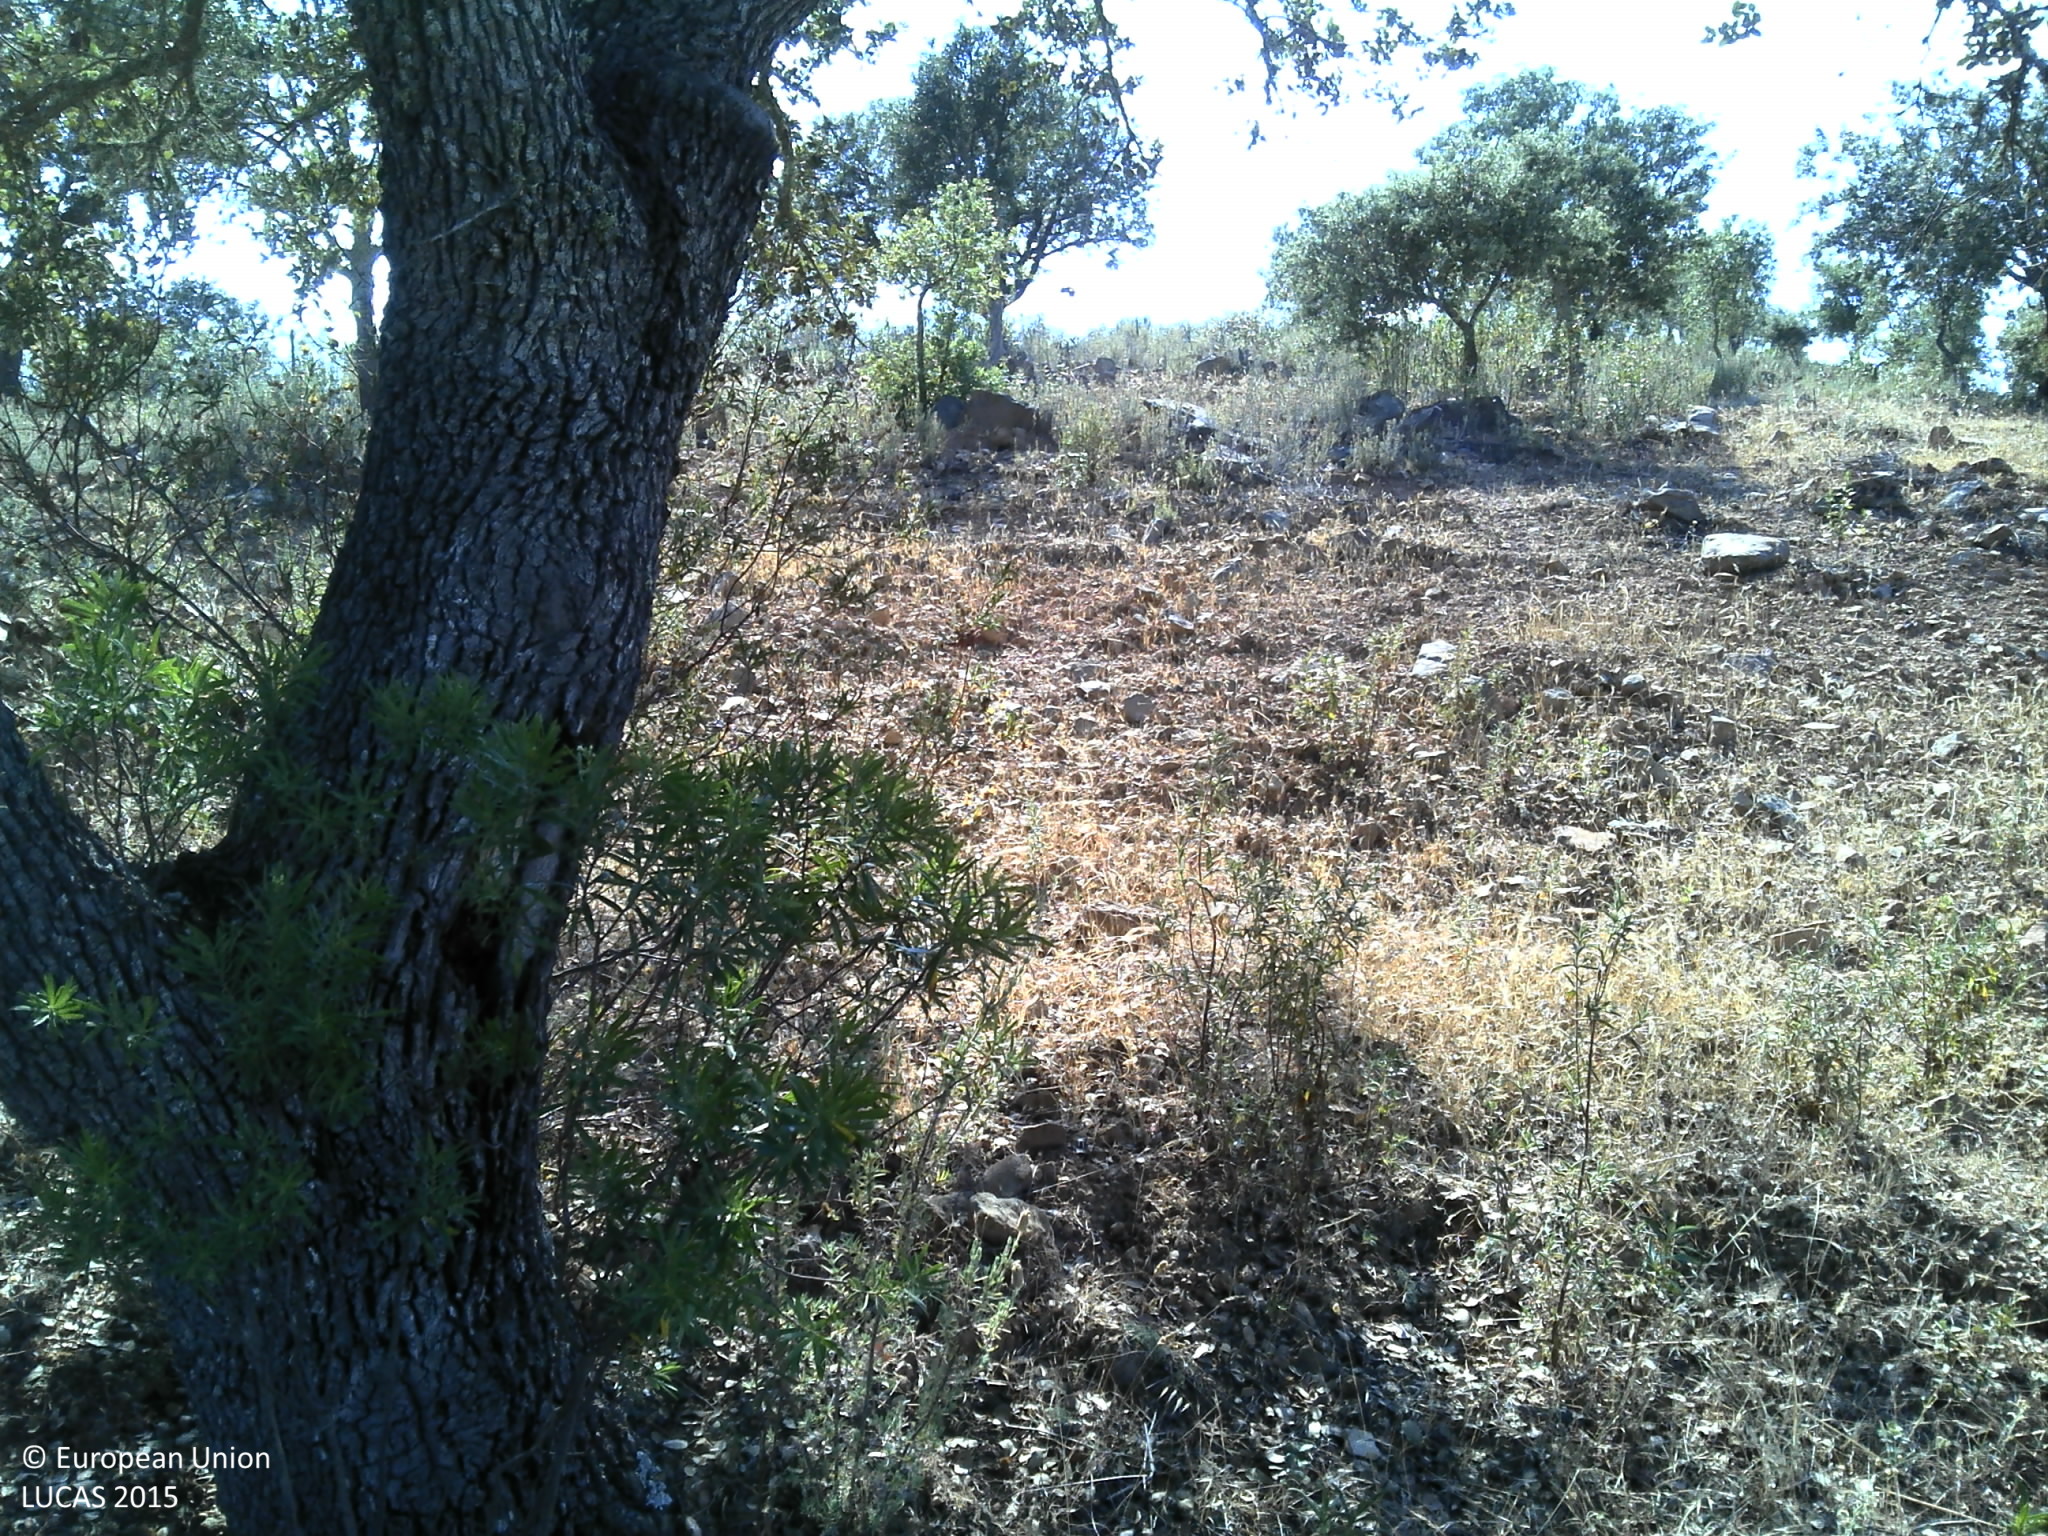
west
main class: Woodland
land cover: Broadleaved woodland
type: broadleaved evergreen forest
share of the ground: 25 - 50 %
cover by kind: broadleaved forest trees 35 %, herbaceous plants 30 %, unconsolidated bare surface 30 %, shrubs 5 %
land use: Forestry
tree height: > 5 m
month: June
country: PT
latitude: 37.4695
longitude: -7.8473
